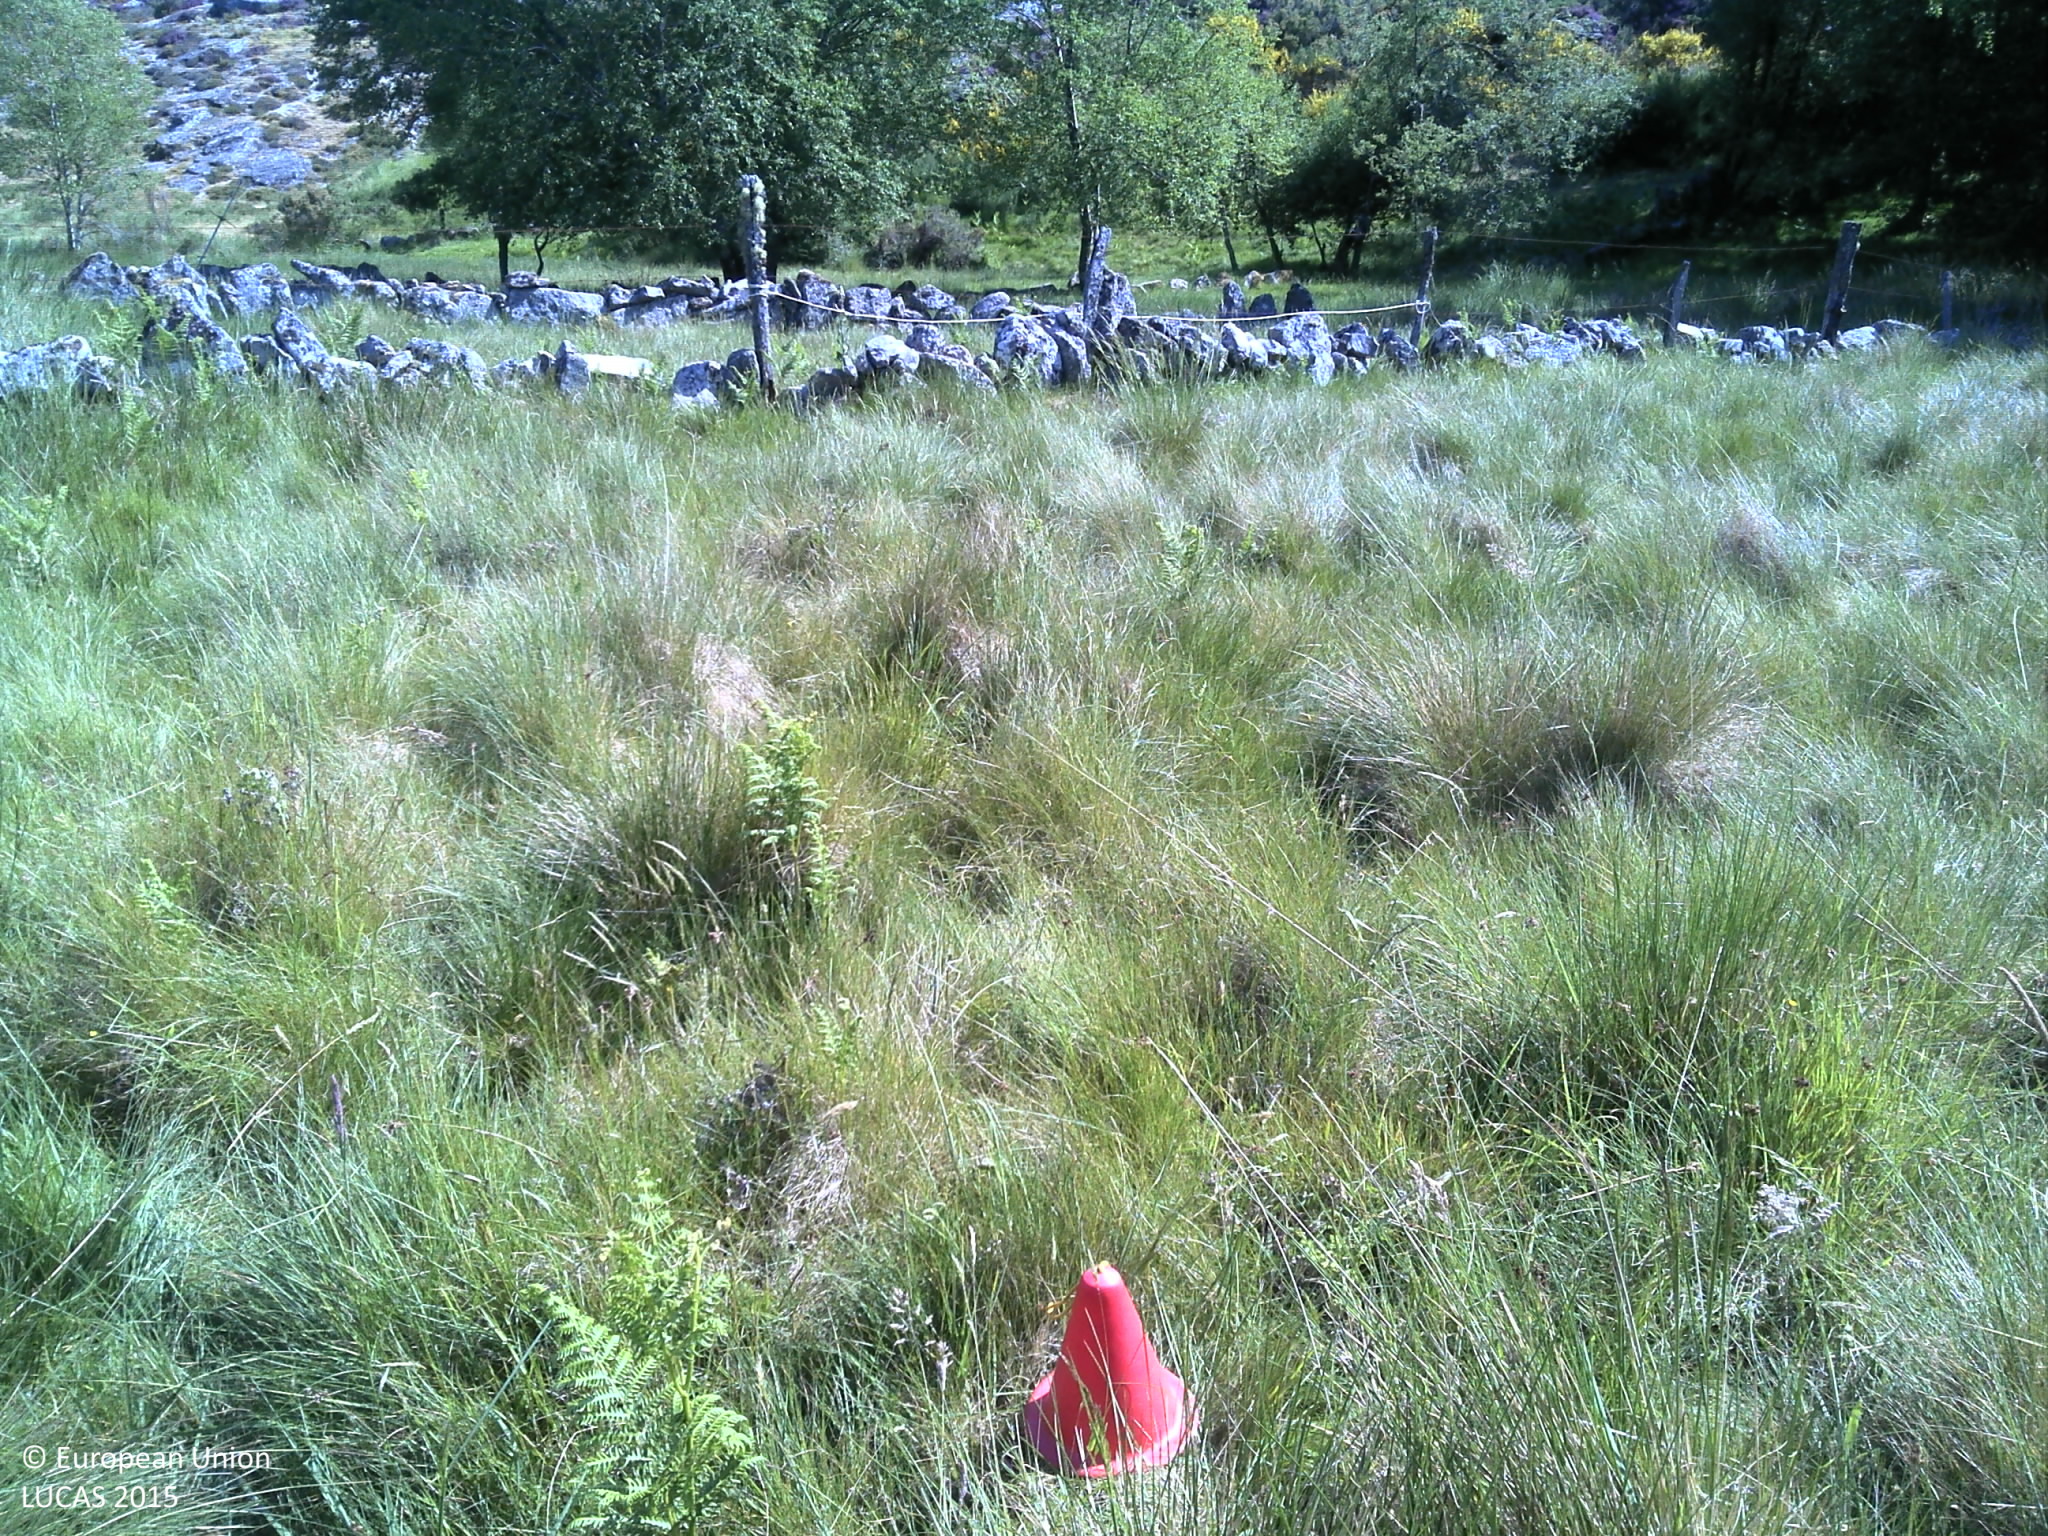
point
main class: Grassland
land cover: Grassland without tree/shrub cover
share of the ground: > 75 %
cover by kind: herbaceous plants 85 %, unconsolidated bare surface 15 %
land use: Agriculture (excluding fallow land and kitchen gardens)
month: June
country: PT
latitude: 42.0470
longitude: -8.1681
